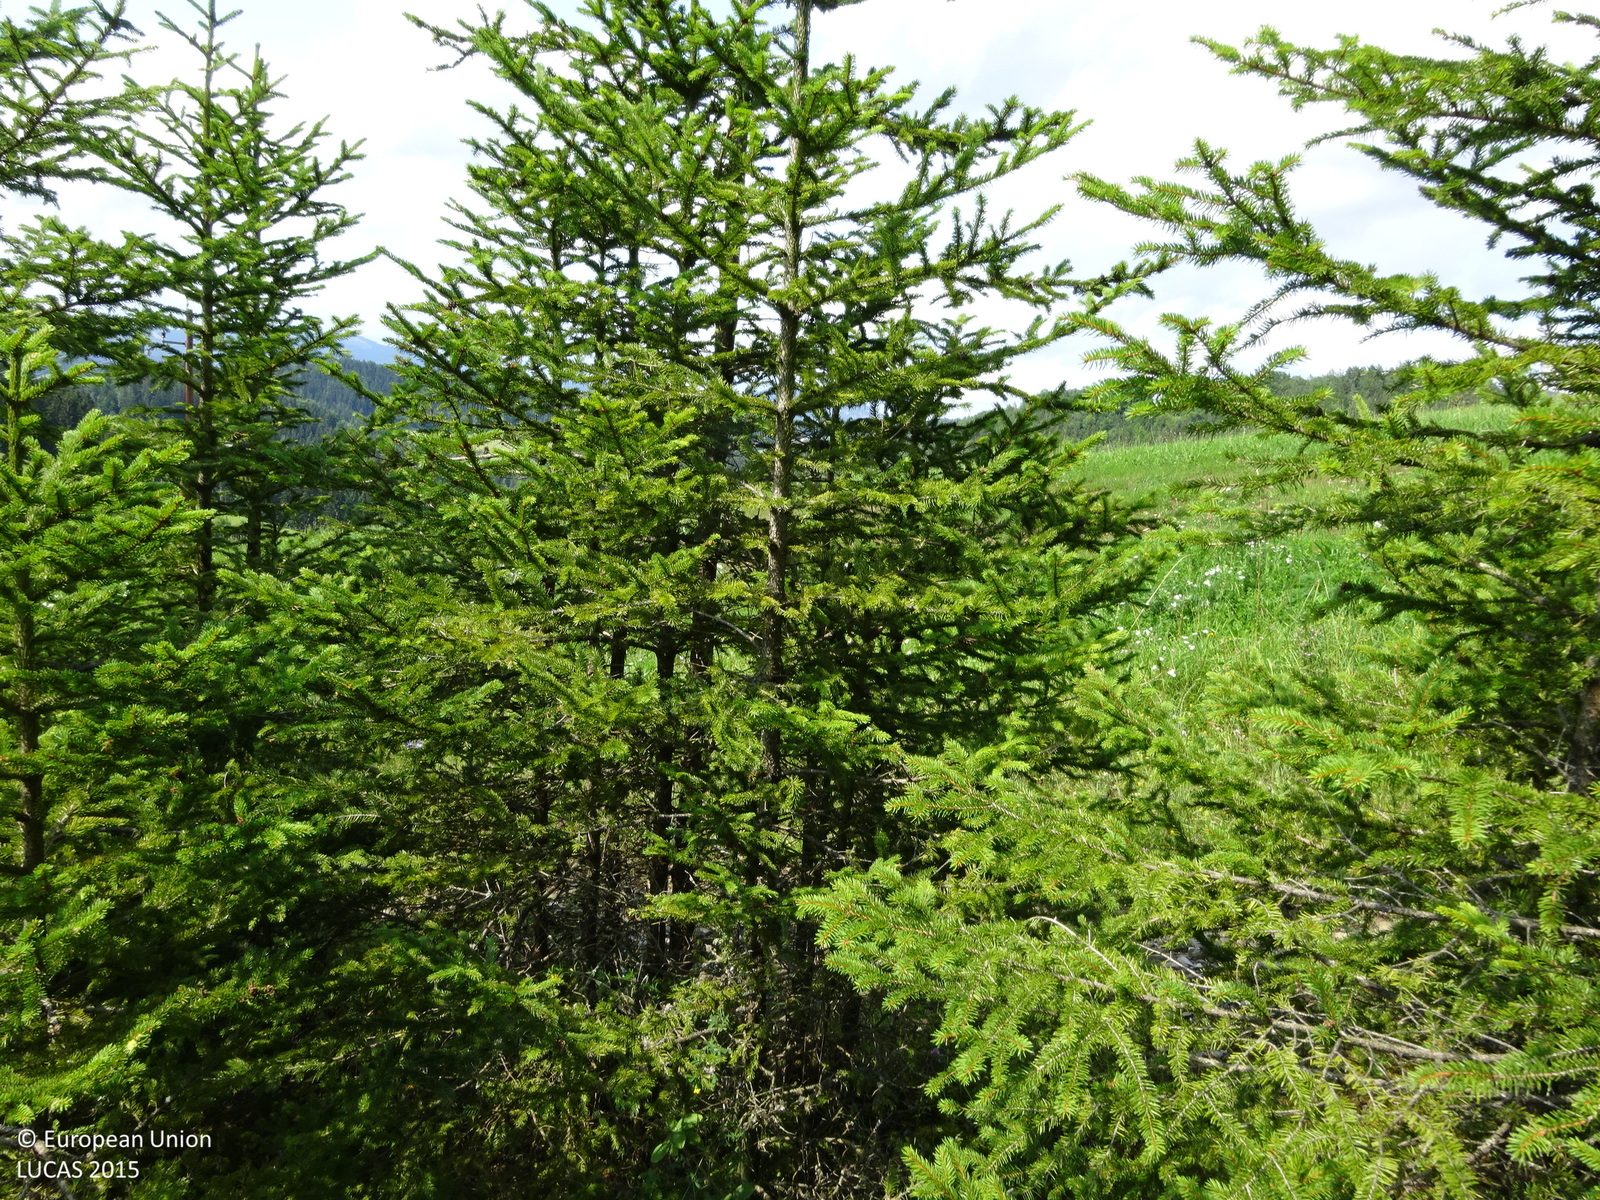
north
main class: Woodland
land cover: Spruce dominated coniferous woodland
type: alpine coniferous forest
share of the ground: 50 - 75 %
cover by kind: coniferous forest trees 70 %, shrubs 25 %, broadleaved forest trees 5 %
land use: Forestry
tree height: < 5 m
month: July
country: AT
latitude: 47.1279
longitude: 15.1802
